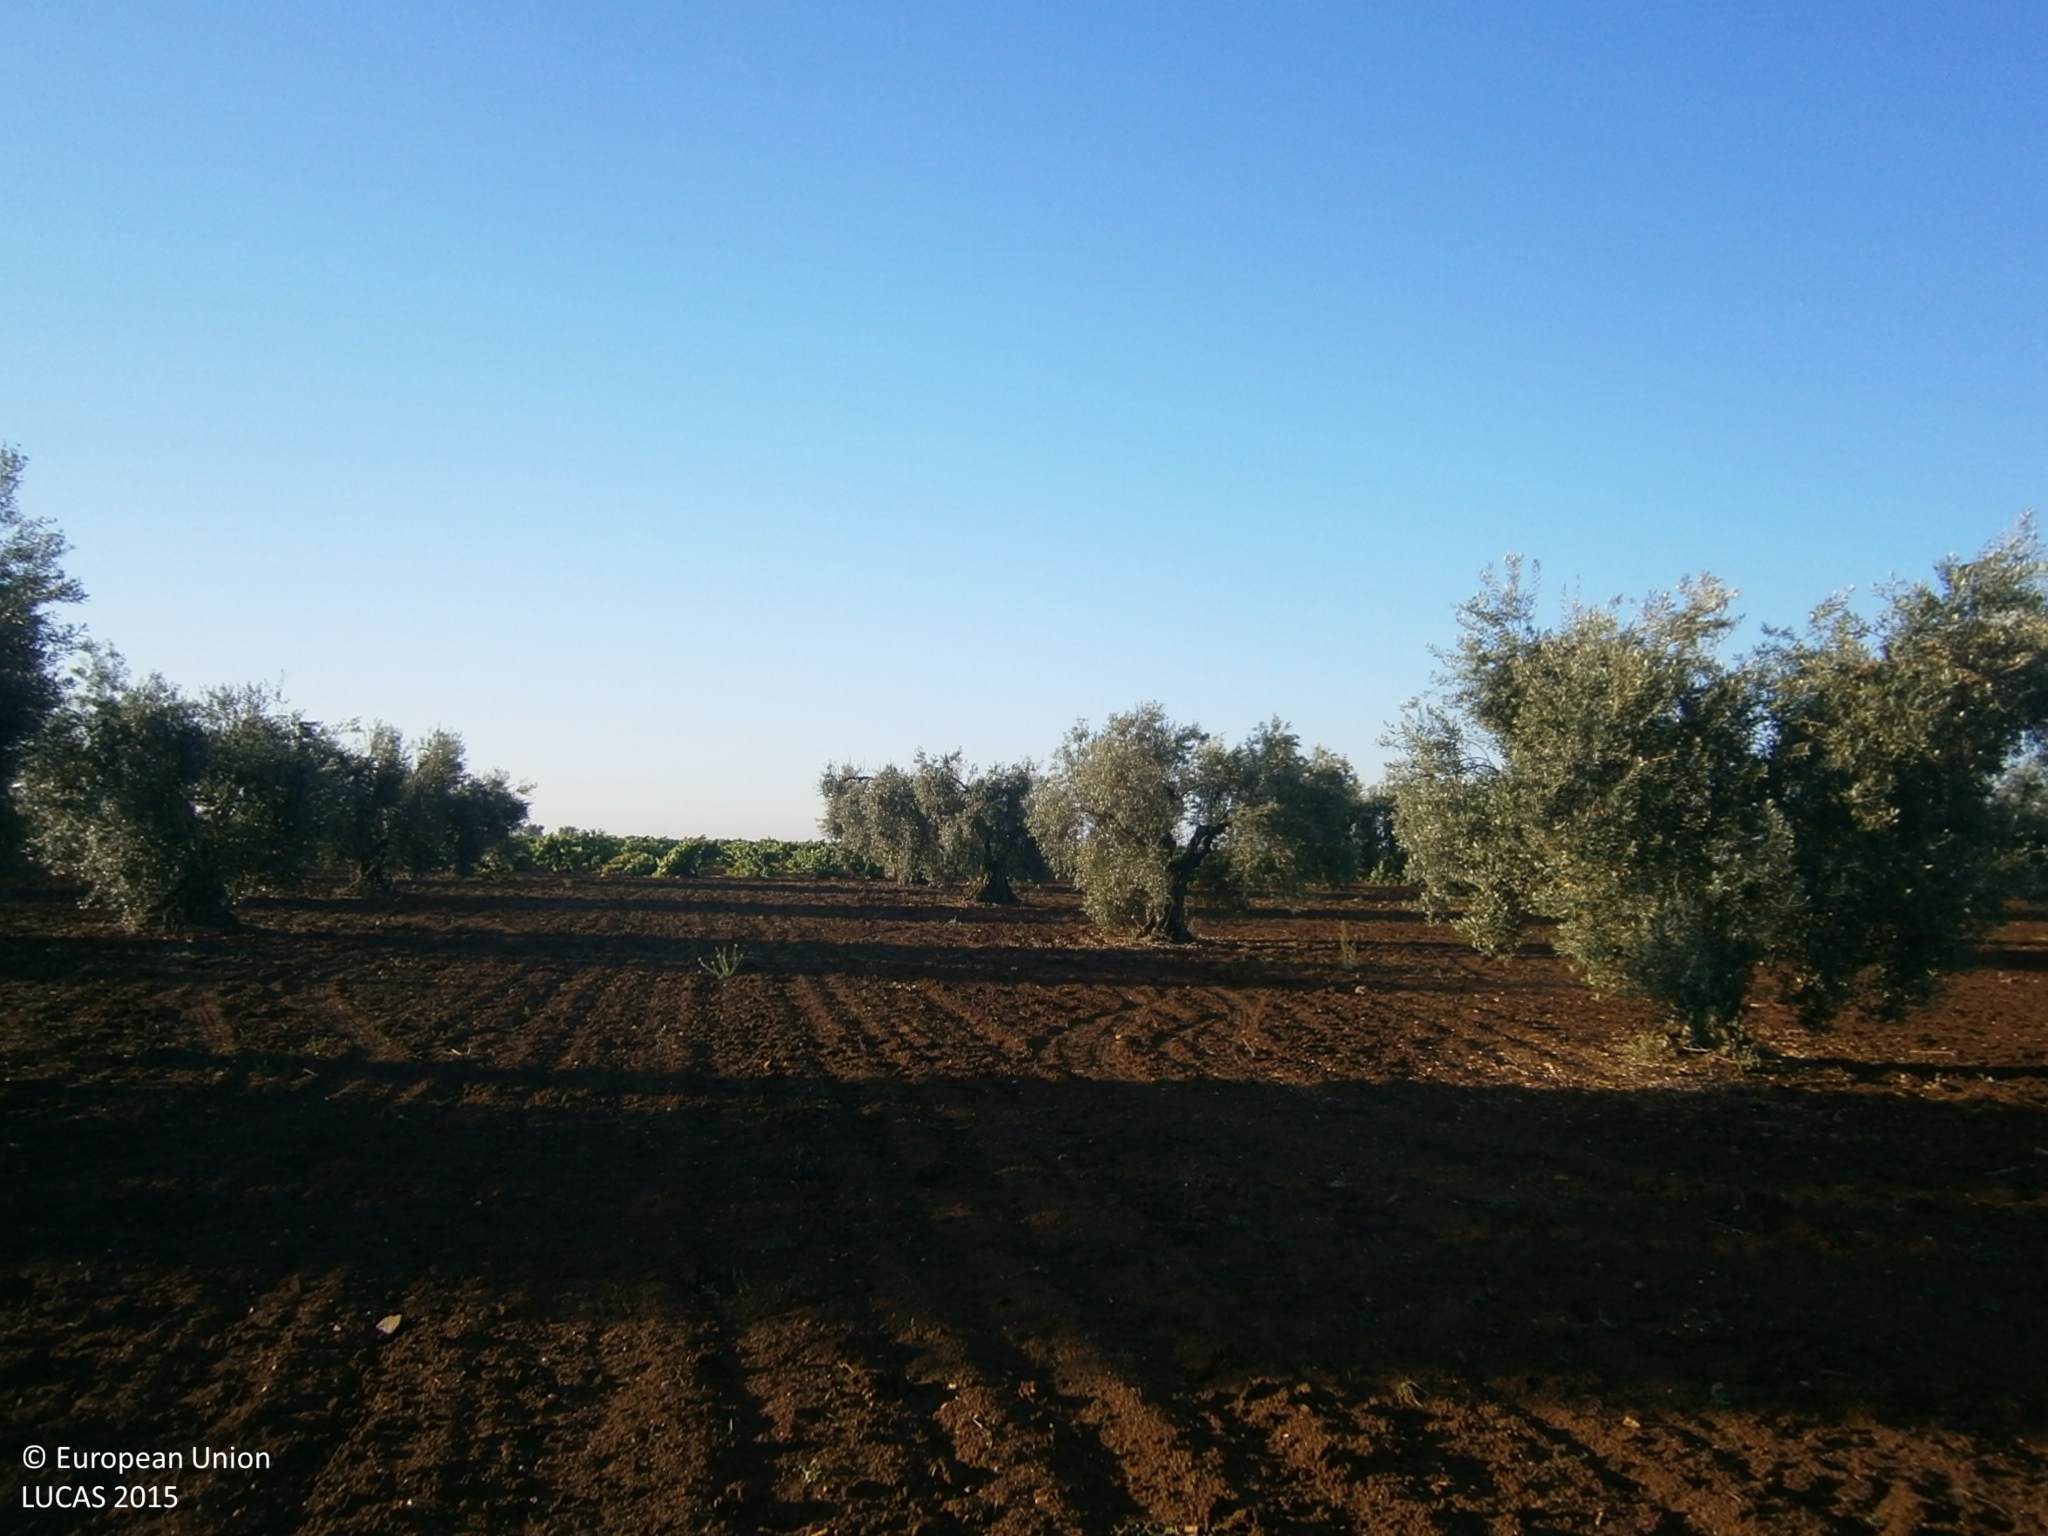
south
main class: Cropland
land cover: Olive groves
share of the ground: 10 - 25 %
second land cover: Other bare soil
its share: > 75 %
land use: Agriculture (excluding fallow land and kitchen gardens)
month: June
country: ES
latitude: 38.7467
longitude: -6.4056
